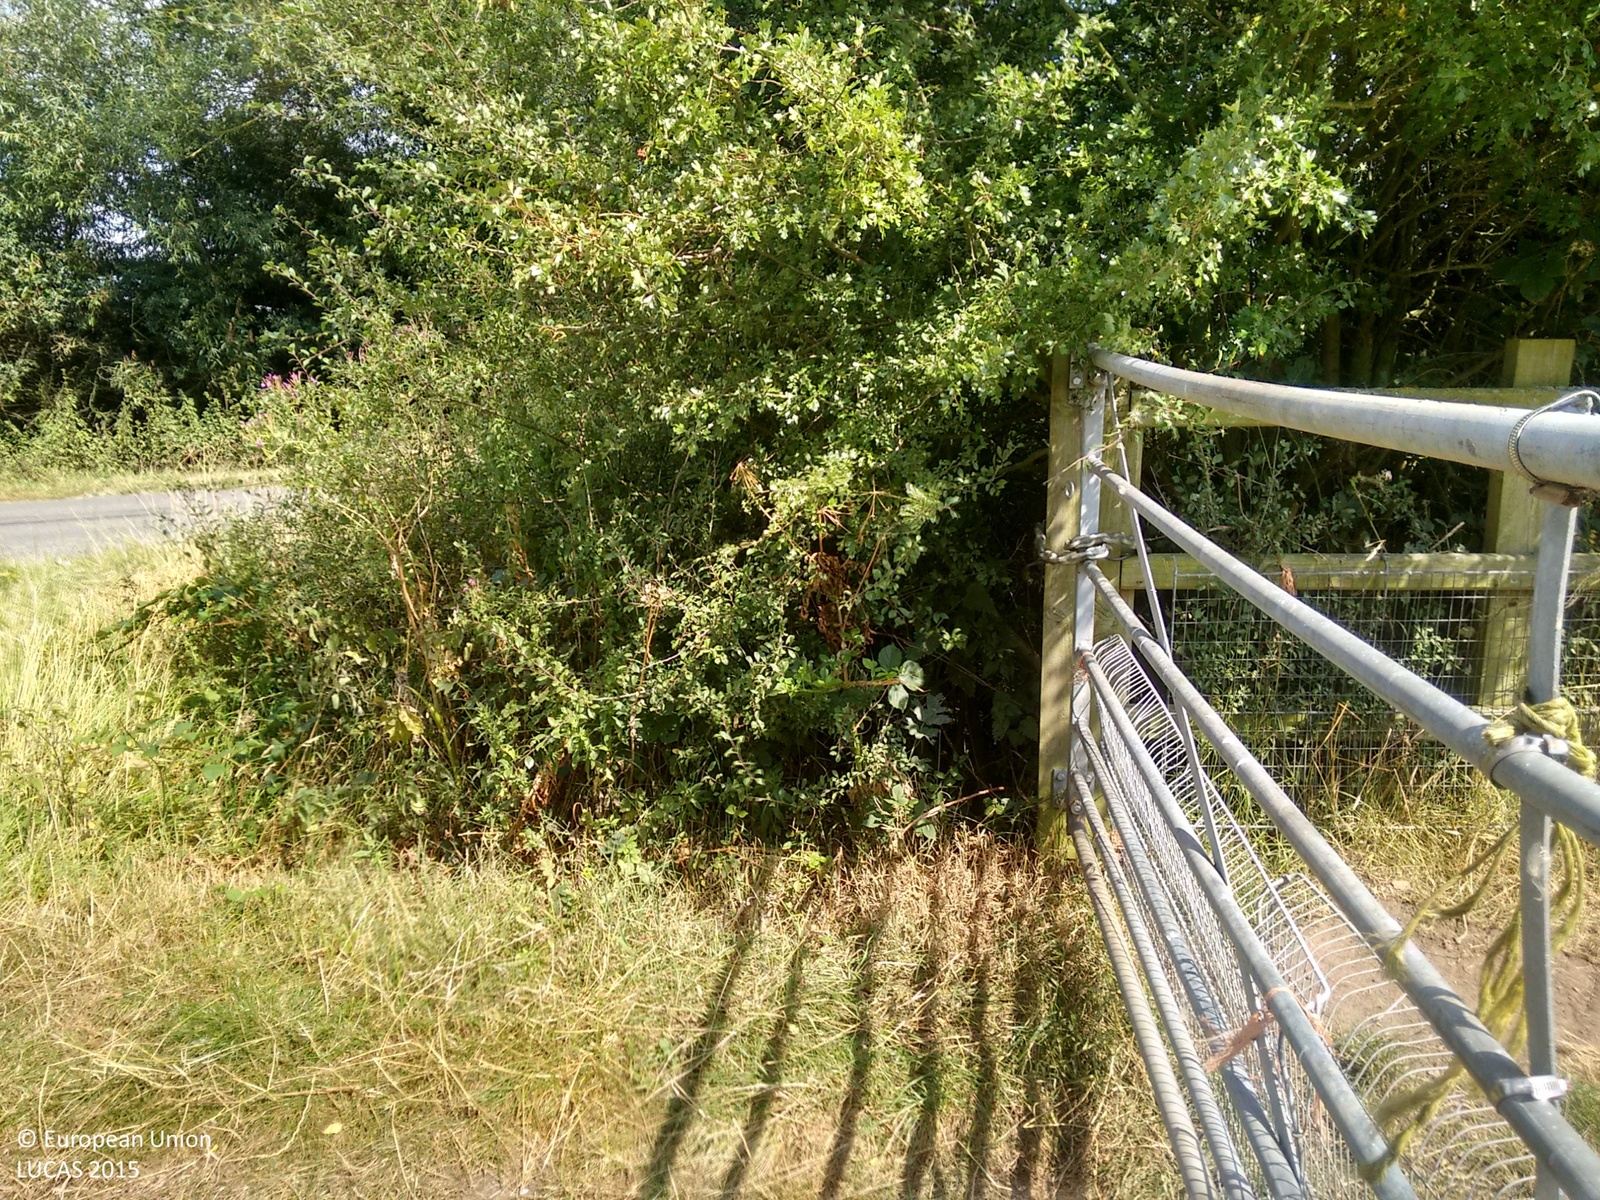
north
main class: Grassland
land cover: Grassland without tree/shrub cover
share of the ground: > 75 %
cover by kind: herbaceous plants 100 %
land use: Agriculture (excluding fallow land and kitchen gardens)
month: August
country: GB
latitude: 52.6160
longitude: -1.4974
